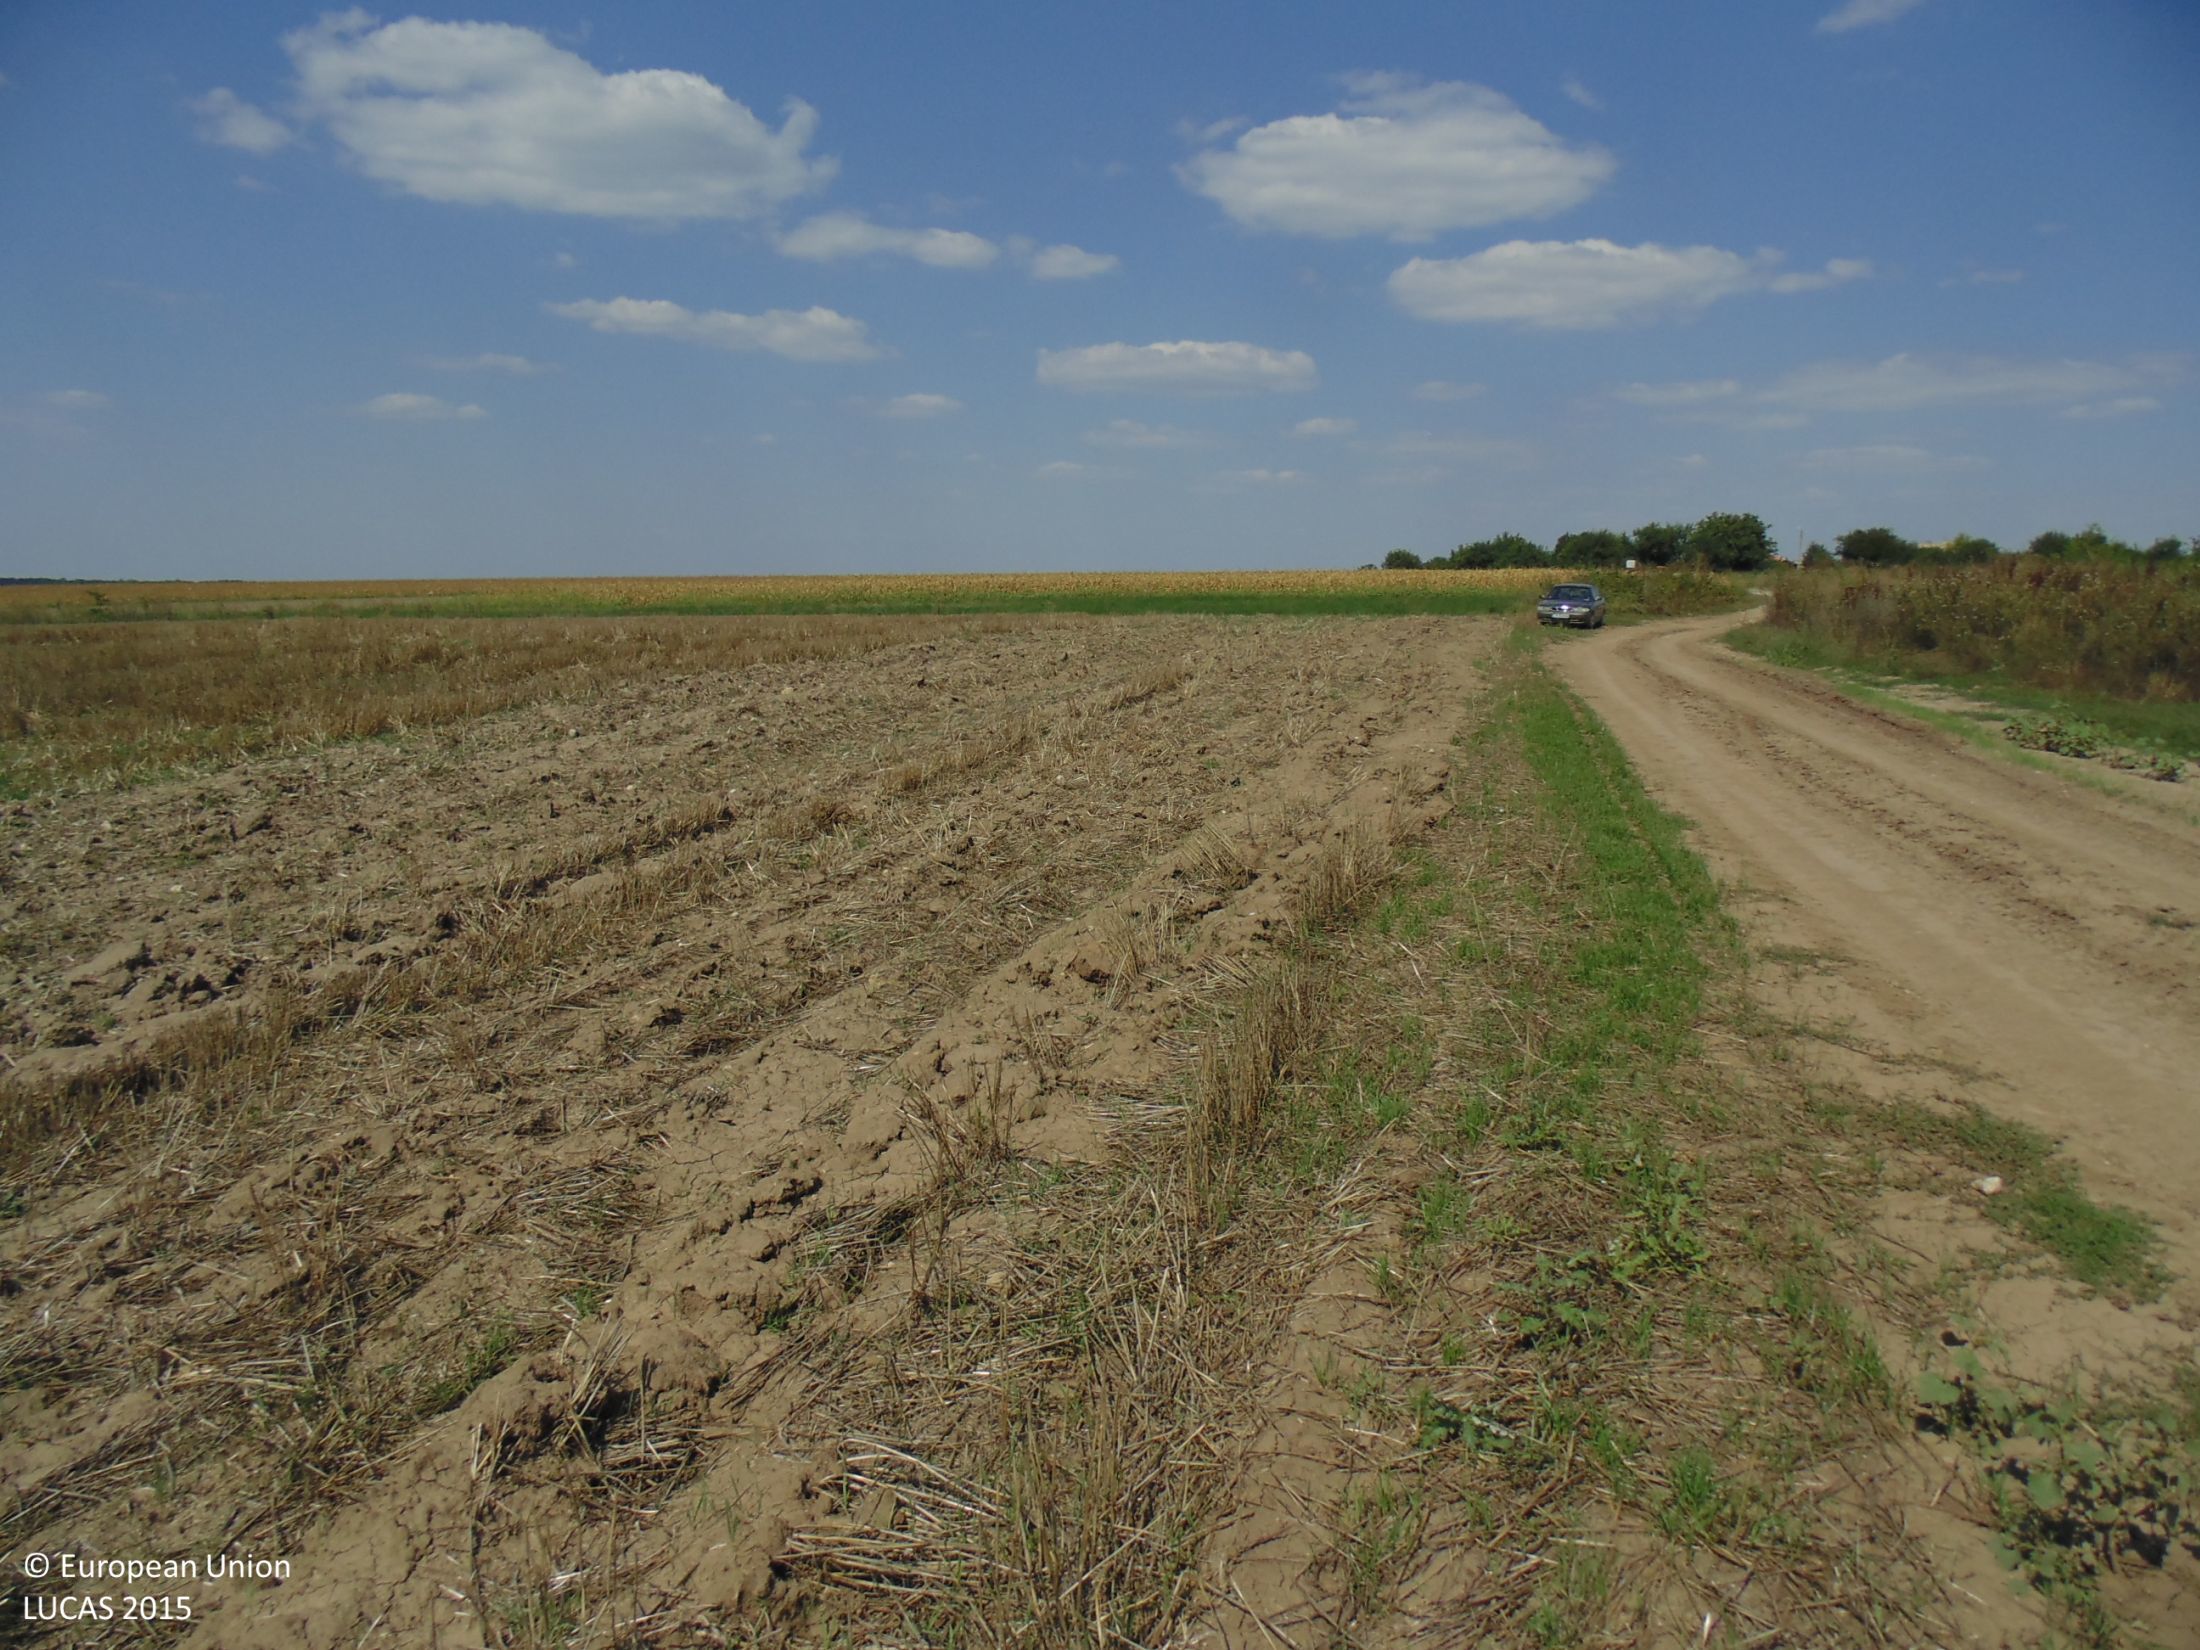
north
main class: Cropland
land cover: Common wheat
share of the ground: 10 - 25 %
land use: Agriculture (excluding fallow land and kitchen gardens)
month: August
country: BG
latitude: 43.6963
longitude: 27.2875
